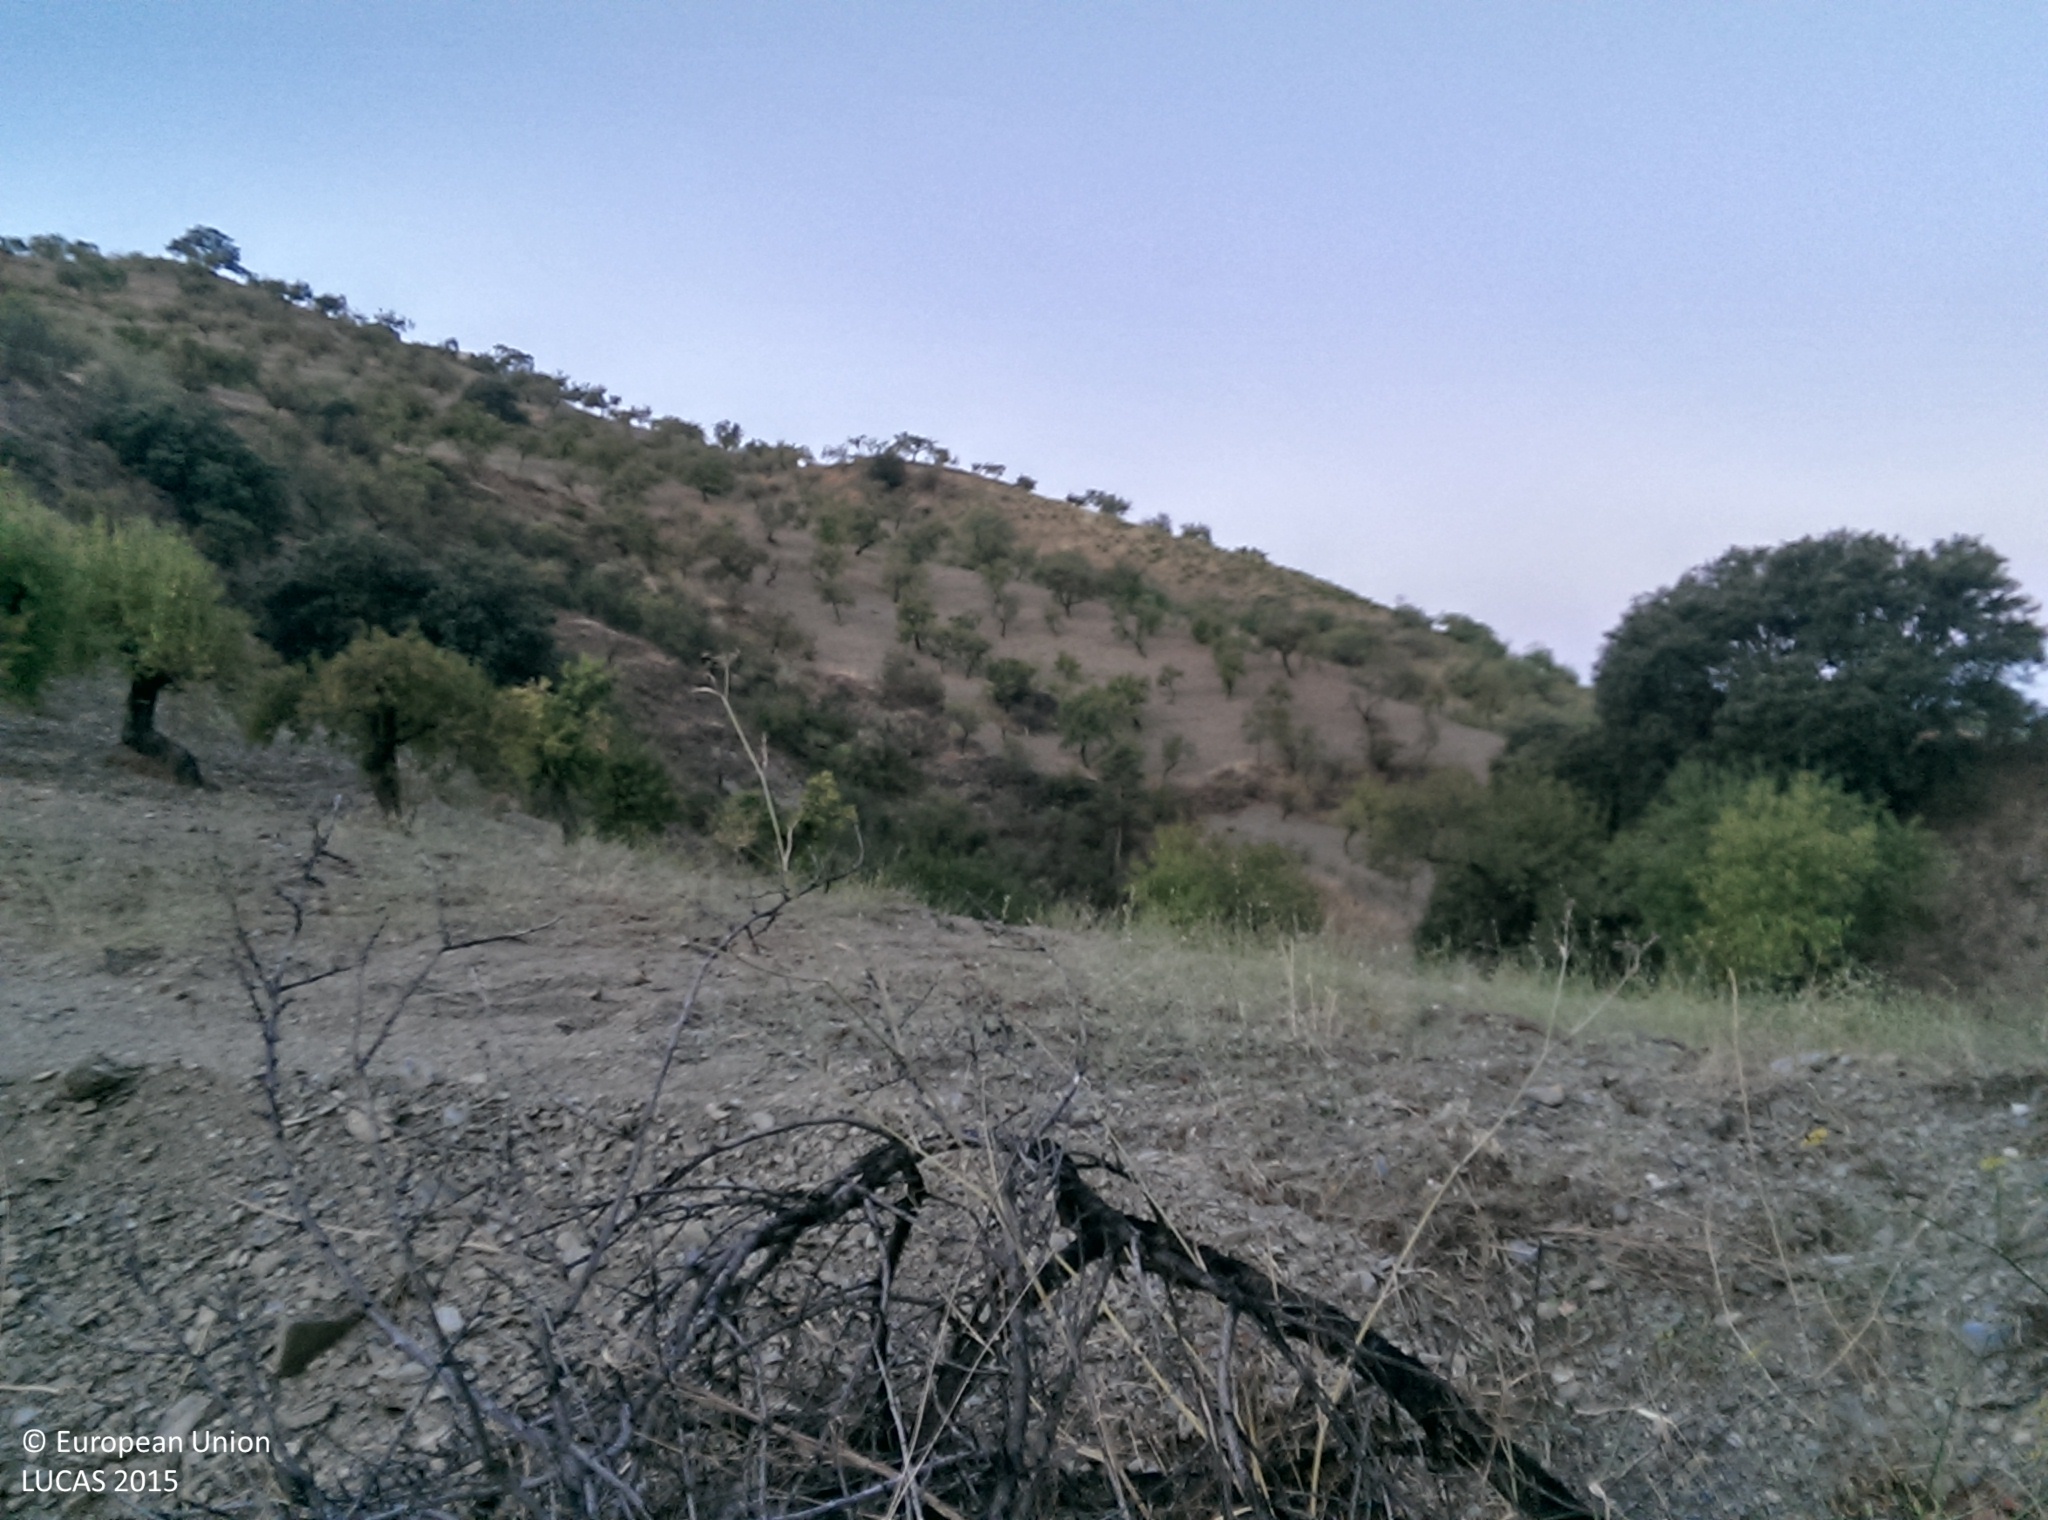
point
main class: Cropland
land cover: Nuts trees
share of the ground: 10 - 25 %
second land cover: Other bare soil
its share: > 75 %
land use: Agriculture (excluding fallow land and kitchen gardens)
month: August
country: ES
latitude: 36.9158
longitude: -3.1929
